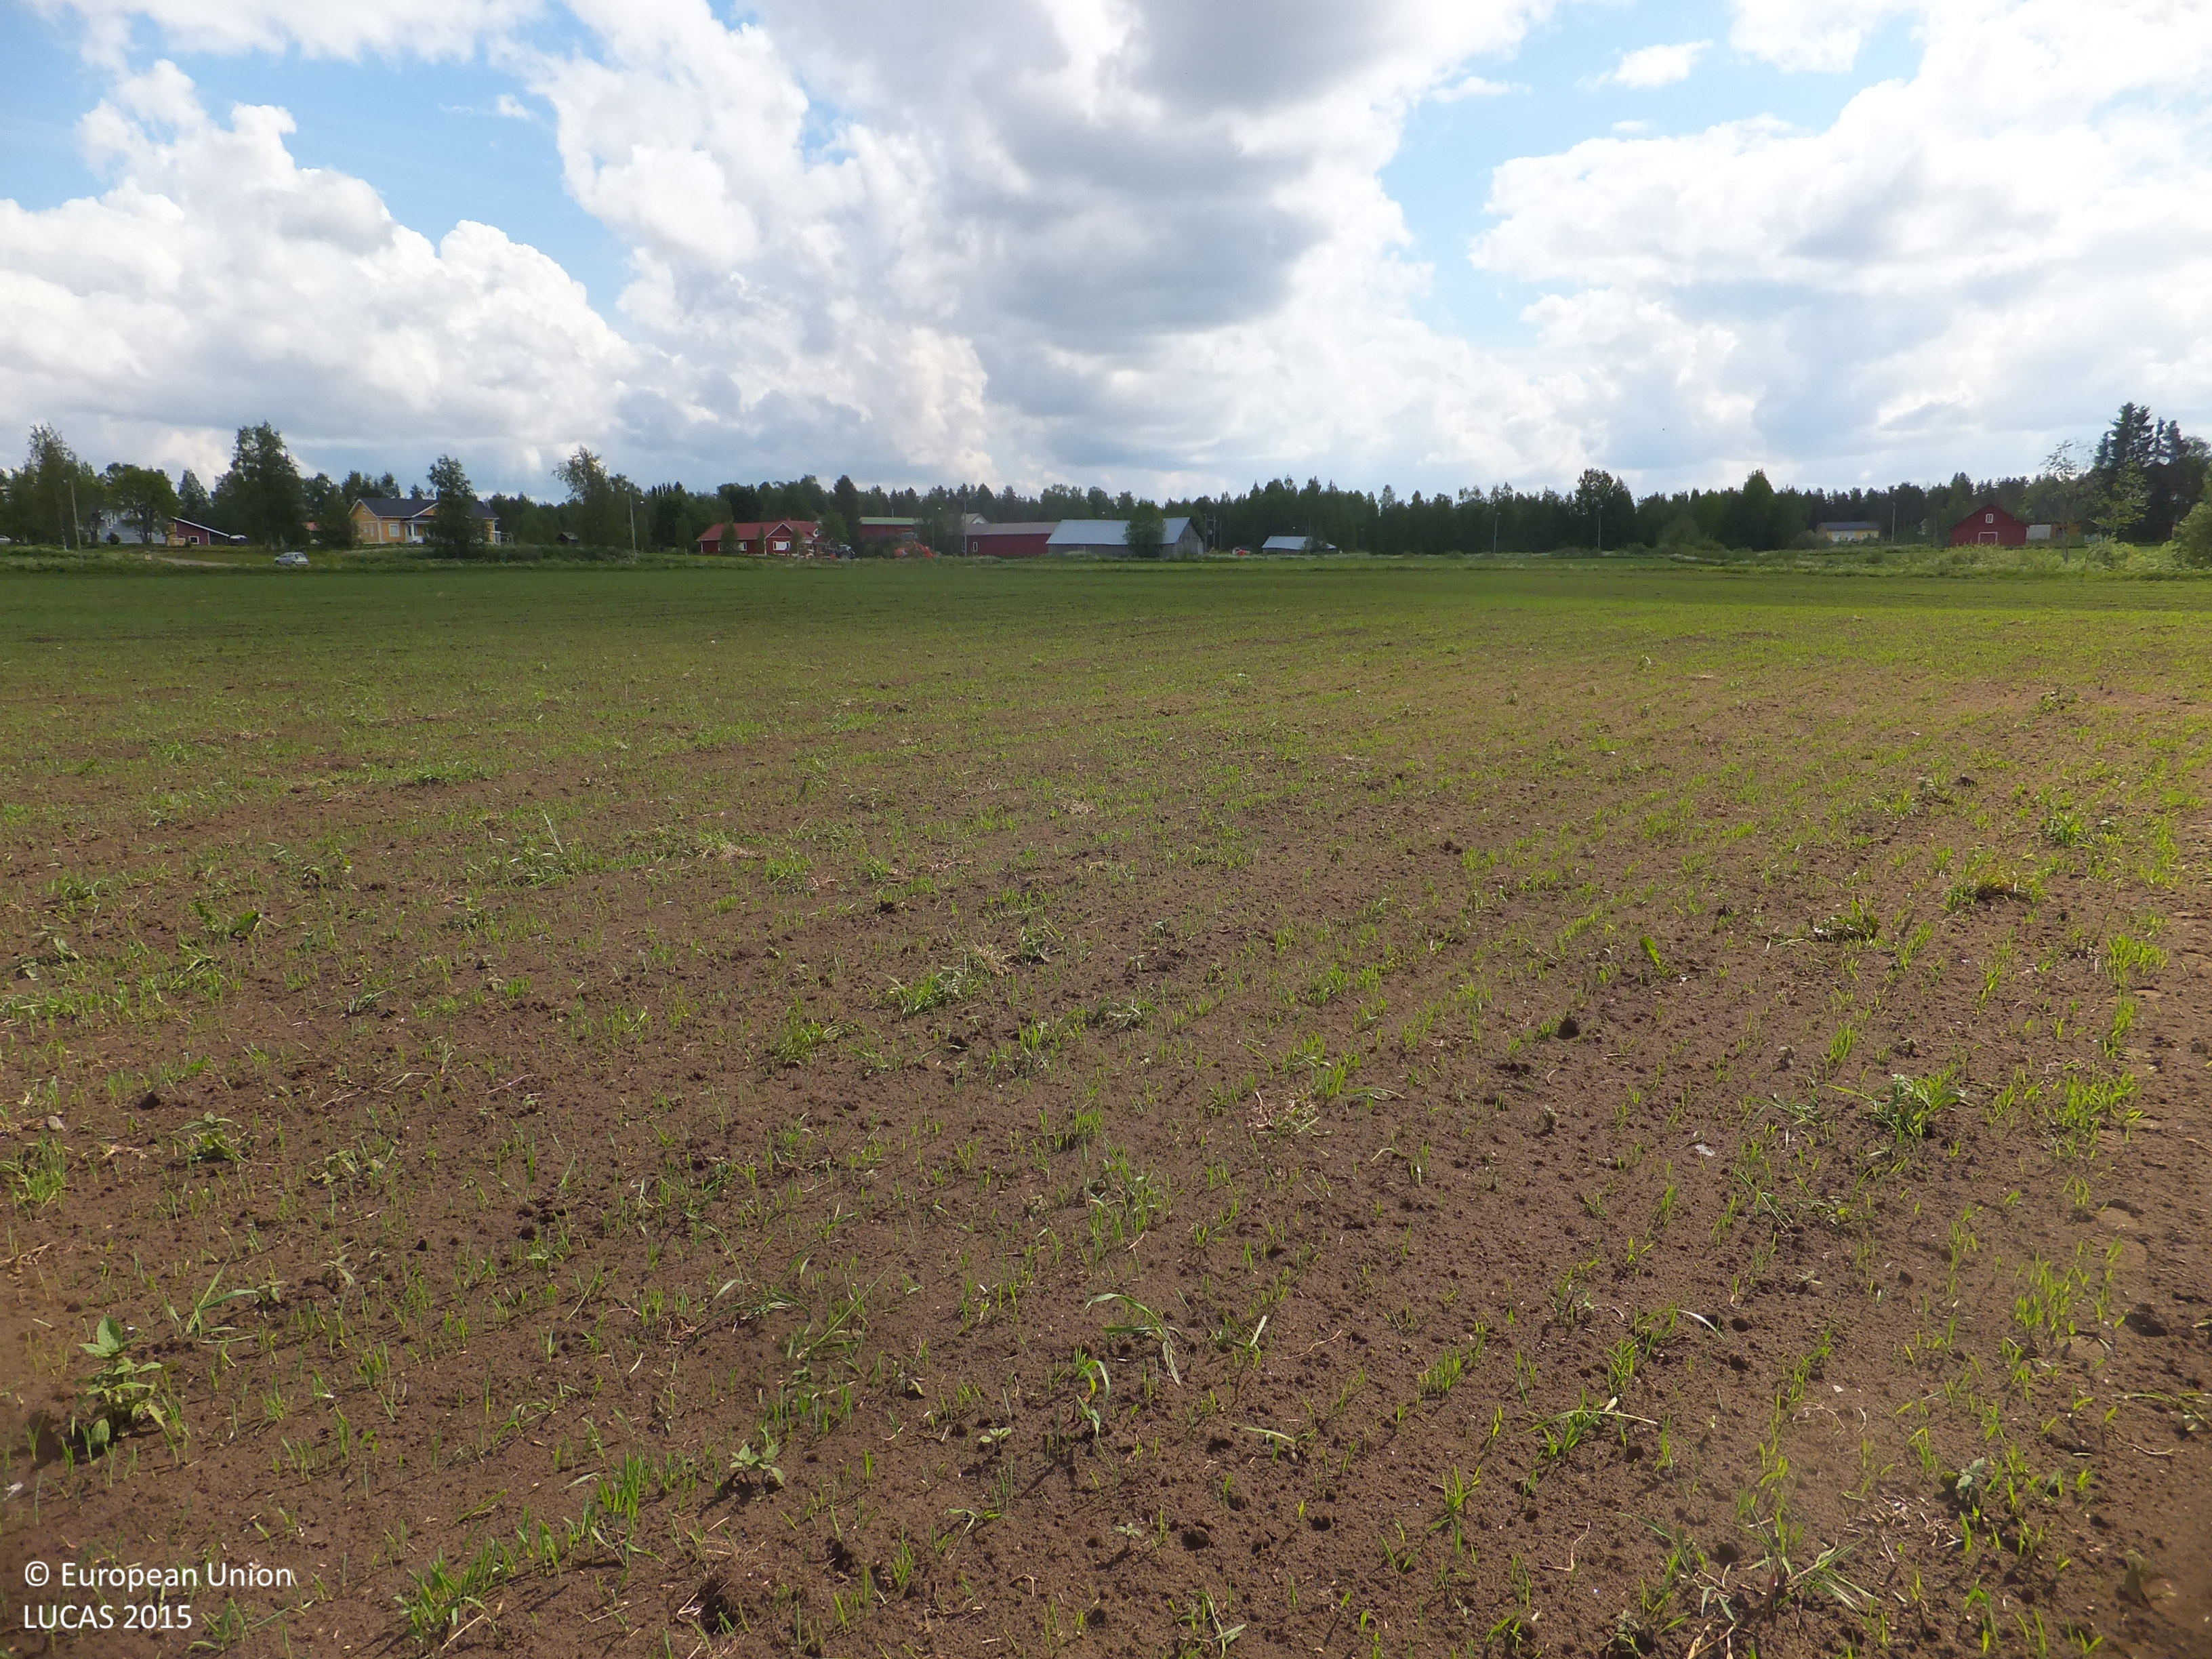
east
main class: Cropland
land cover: Barley
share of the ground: < 10 %
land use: Agriculture (excluding fallow land and kitchen gardens)
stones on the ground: < 10 %
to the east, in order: Barley; Ditches and canals; Grass margins; Paved roads, cycling and walking lanes; Electric lines; Grass margins; Ditches and canals; Grassland without tree/shrub cover; Lines of trees; Grassland without tree/shrub cover
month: June
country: FI
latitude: 63.6006
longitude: 24.0813
